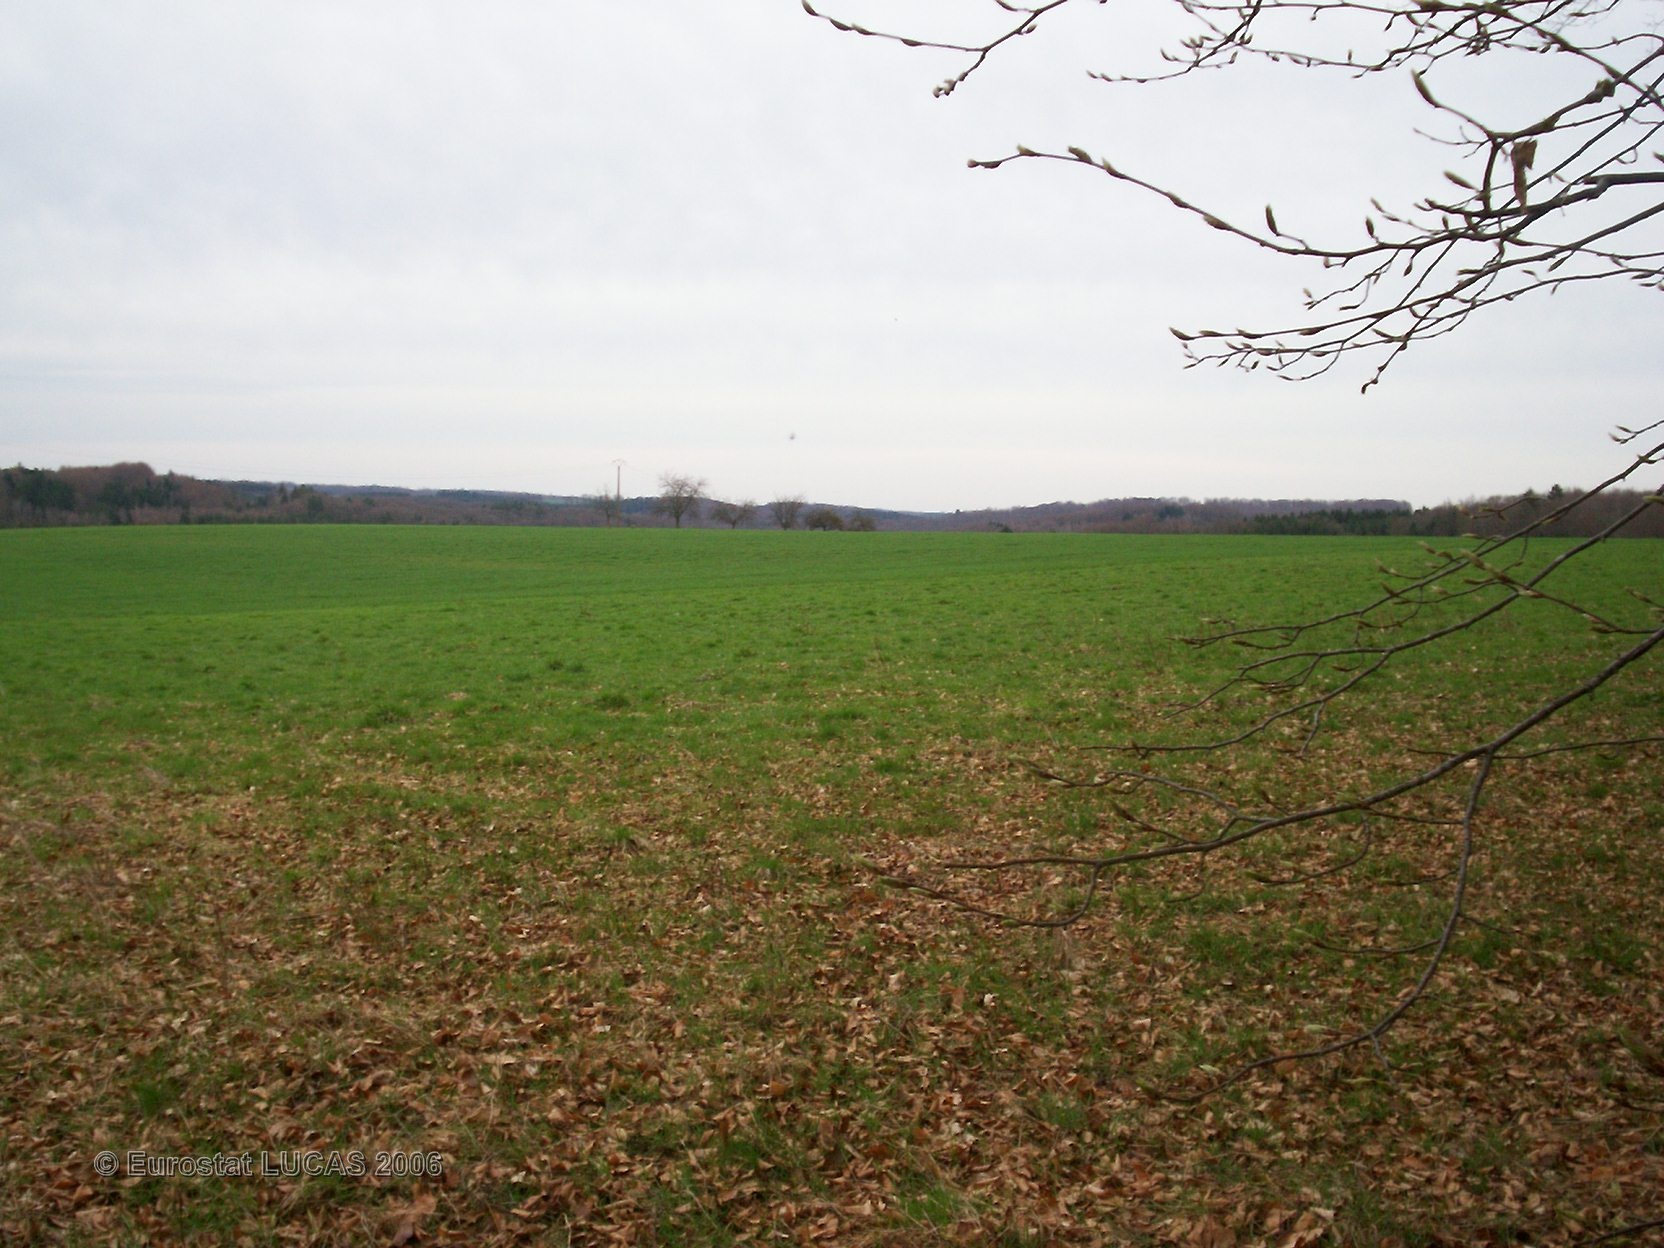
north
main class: Woodland
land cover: Broadleaved forest
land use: Forestry
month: April
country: FR
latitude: 48.0160
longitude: 6.2603
